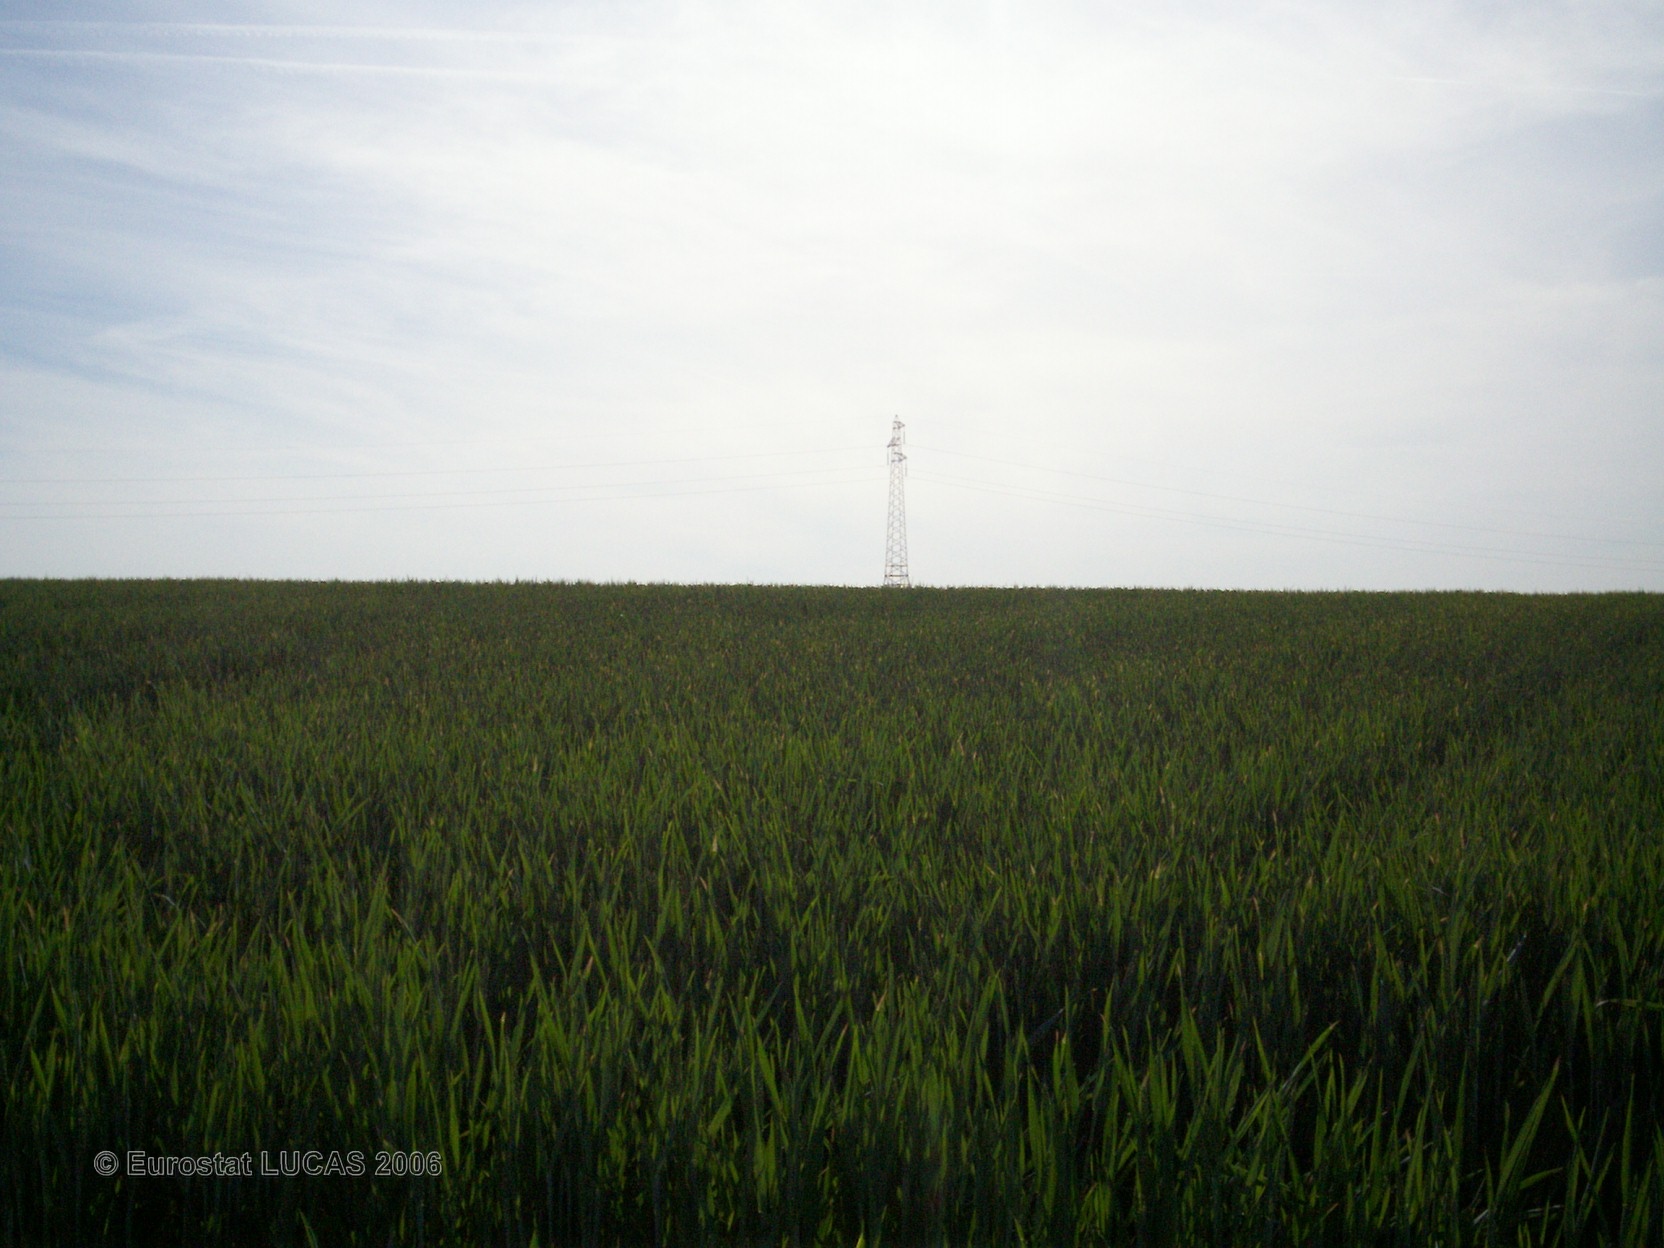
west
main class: Cropland
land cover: Common wheat
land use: Agriculture (excluding fallow land and kitchen gardens)
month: May
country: FR
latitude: 46.1184
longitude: -0.1796
